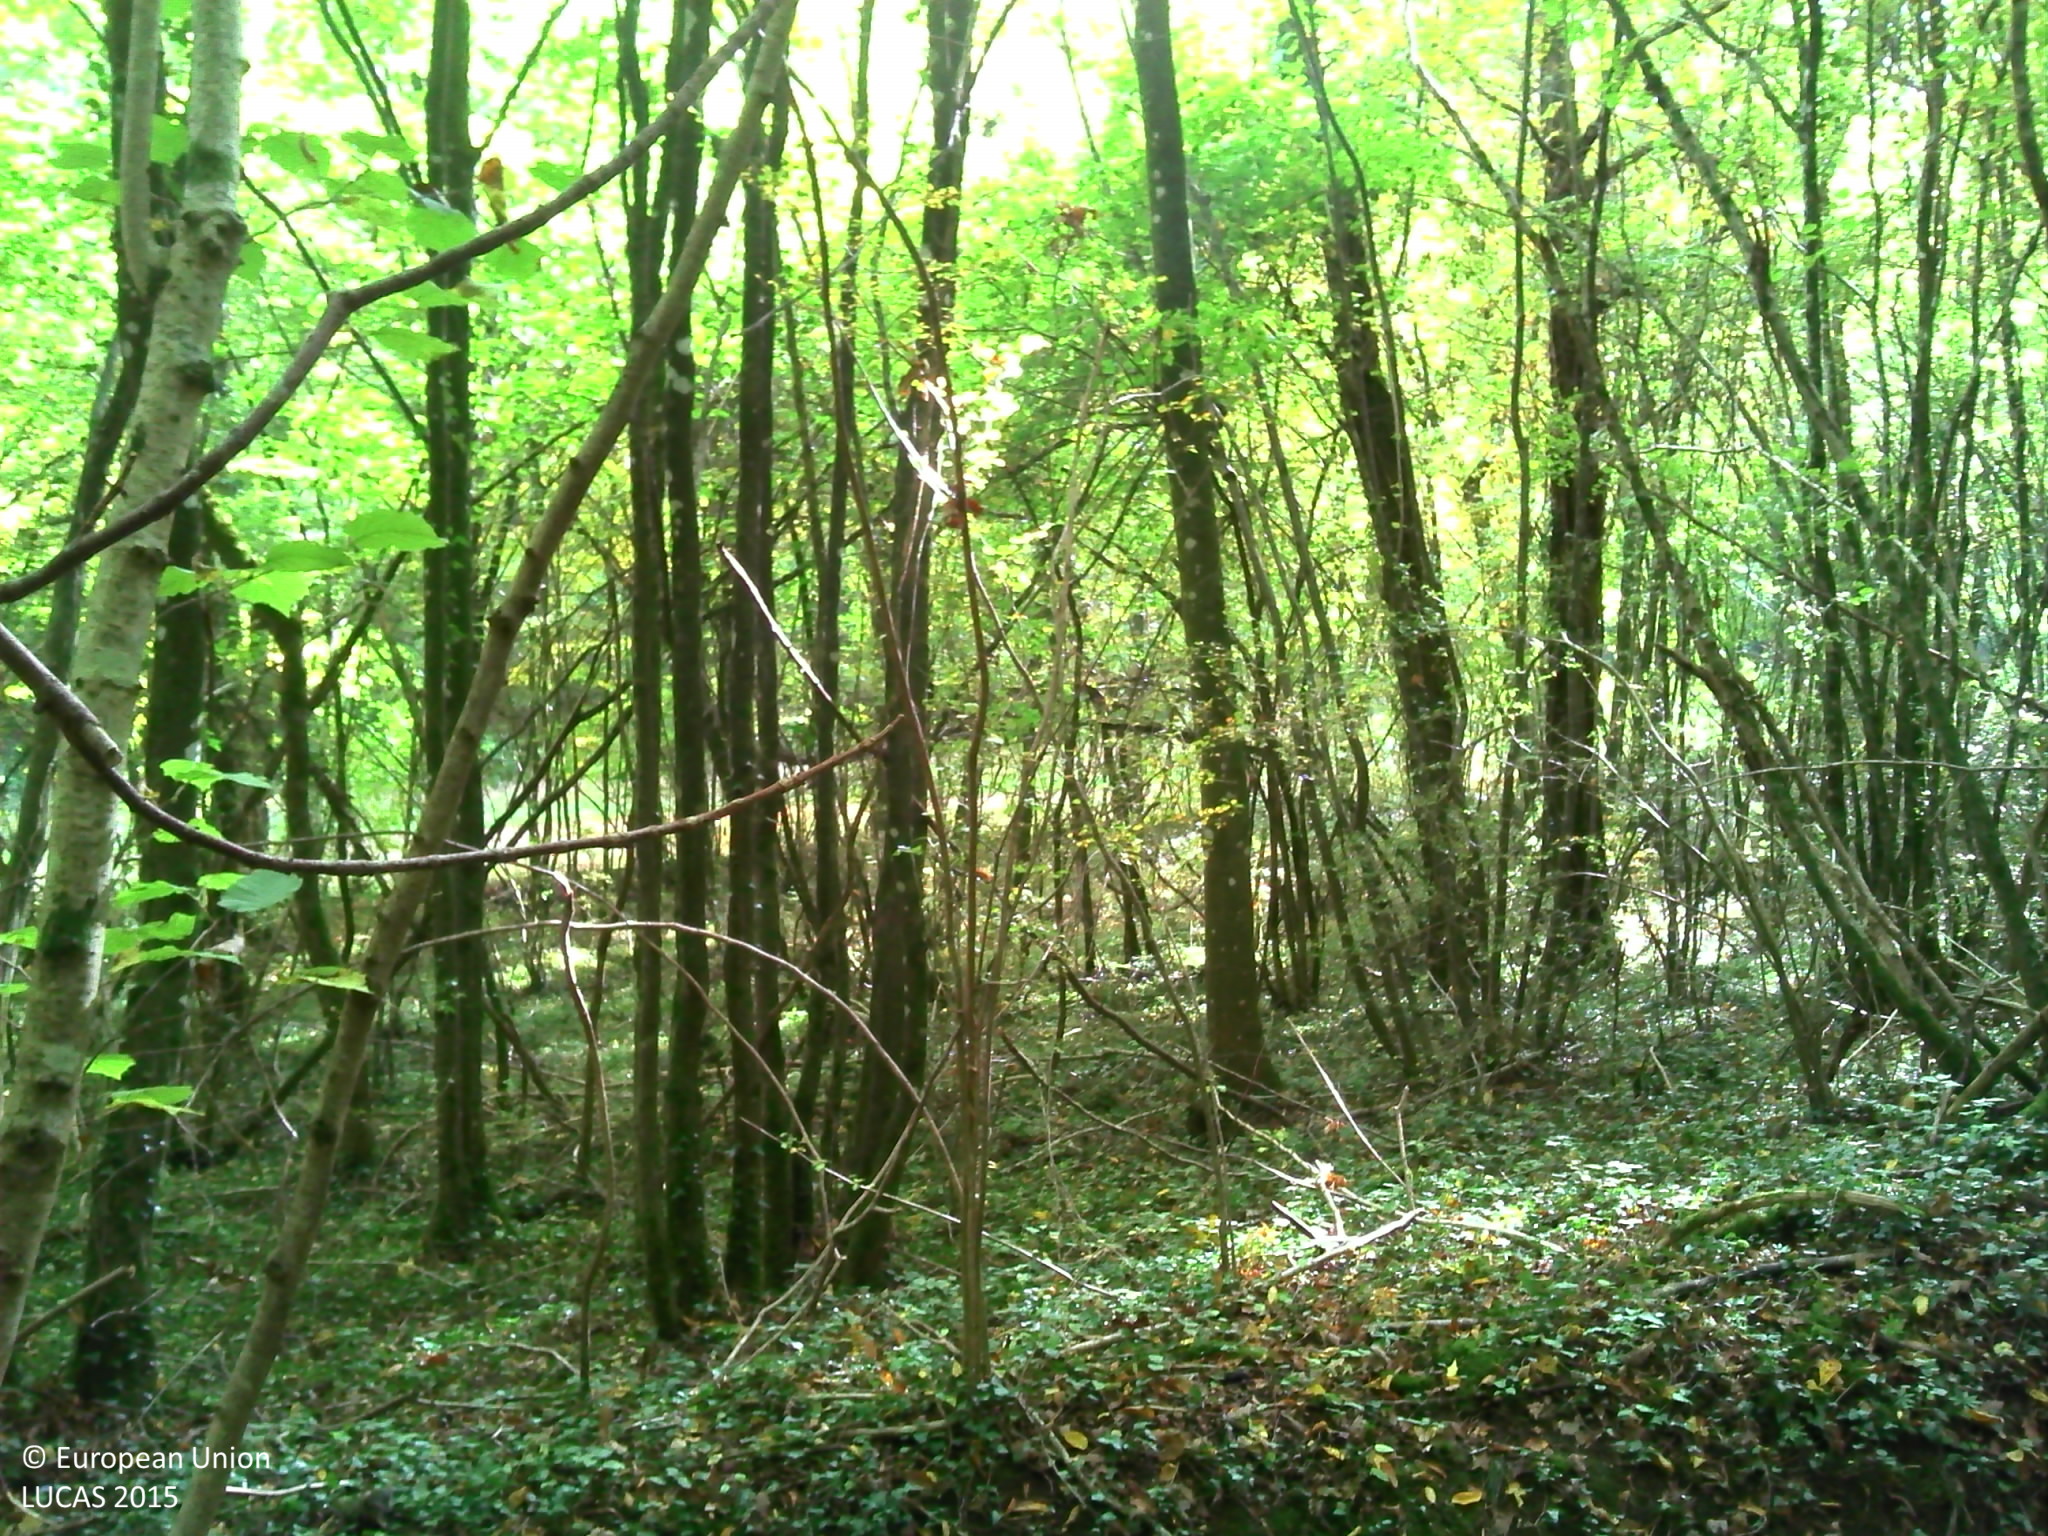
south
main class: Woodland
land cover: Broadleaved woodland
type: mesophytic deciduous forest
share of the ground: > 75 %
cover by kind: broadleaved forest trees 90 %, herbaceous plants 10 %
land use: Forestry
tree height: > 5 m
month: October
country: FR
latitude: 49.6062
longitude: 5.0019
